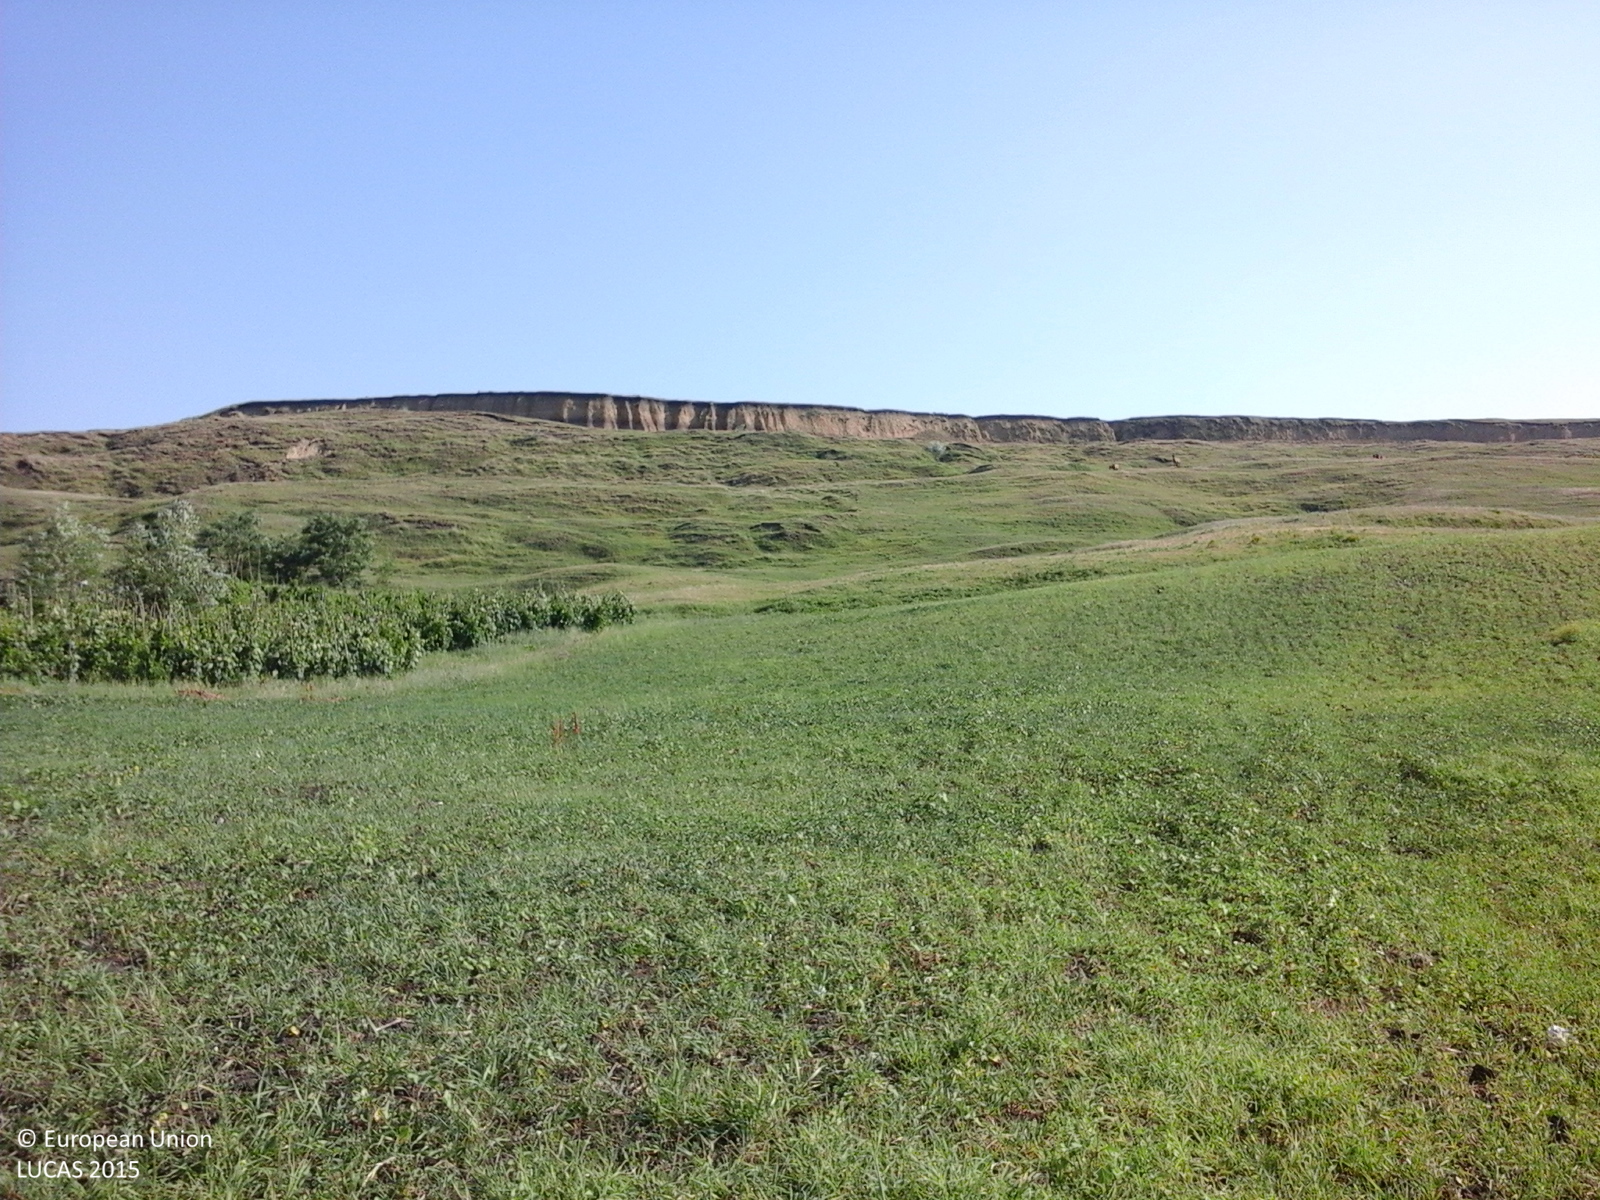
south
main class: Grassland
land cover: Grassland without tree/shrub cover
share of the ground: > 75 %
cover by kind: herbaceous plants 100 %
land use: Agriculture (excluding fallow land and kitchen gardens)
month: June
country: RO
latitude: 46.8225
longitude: 27.7511
